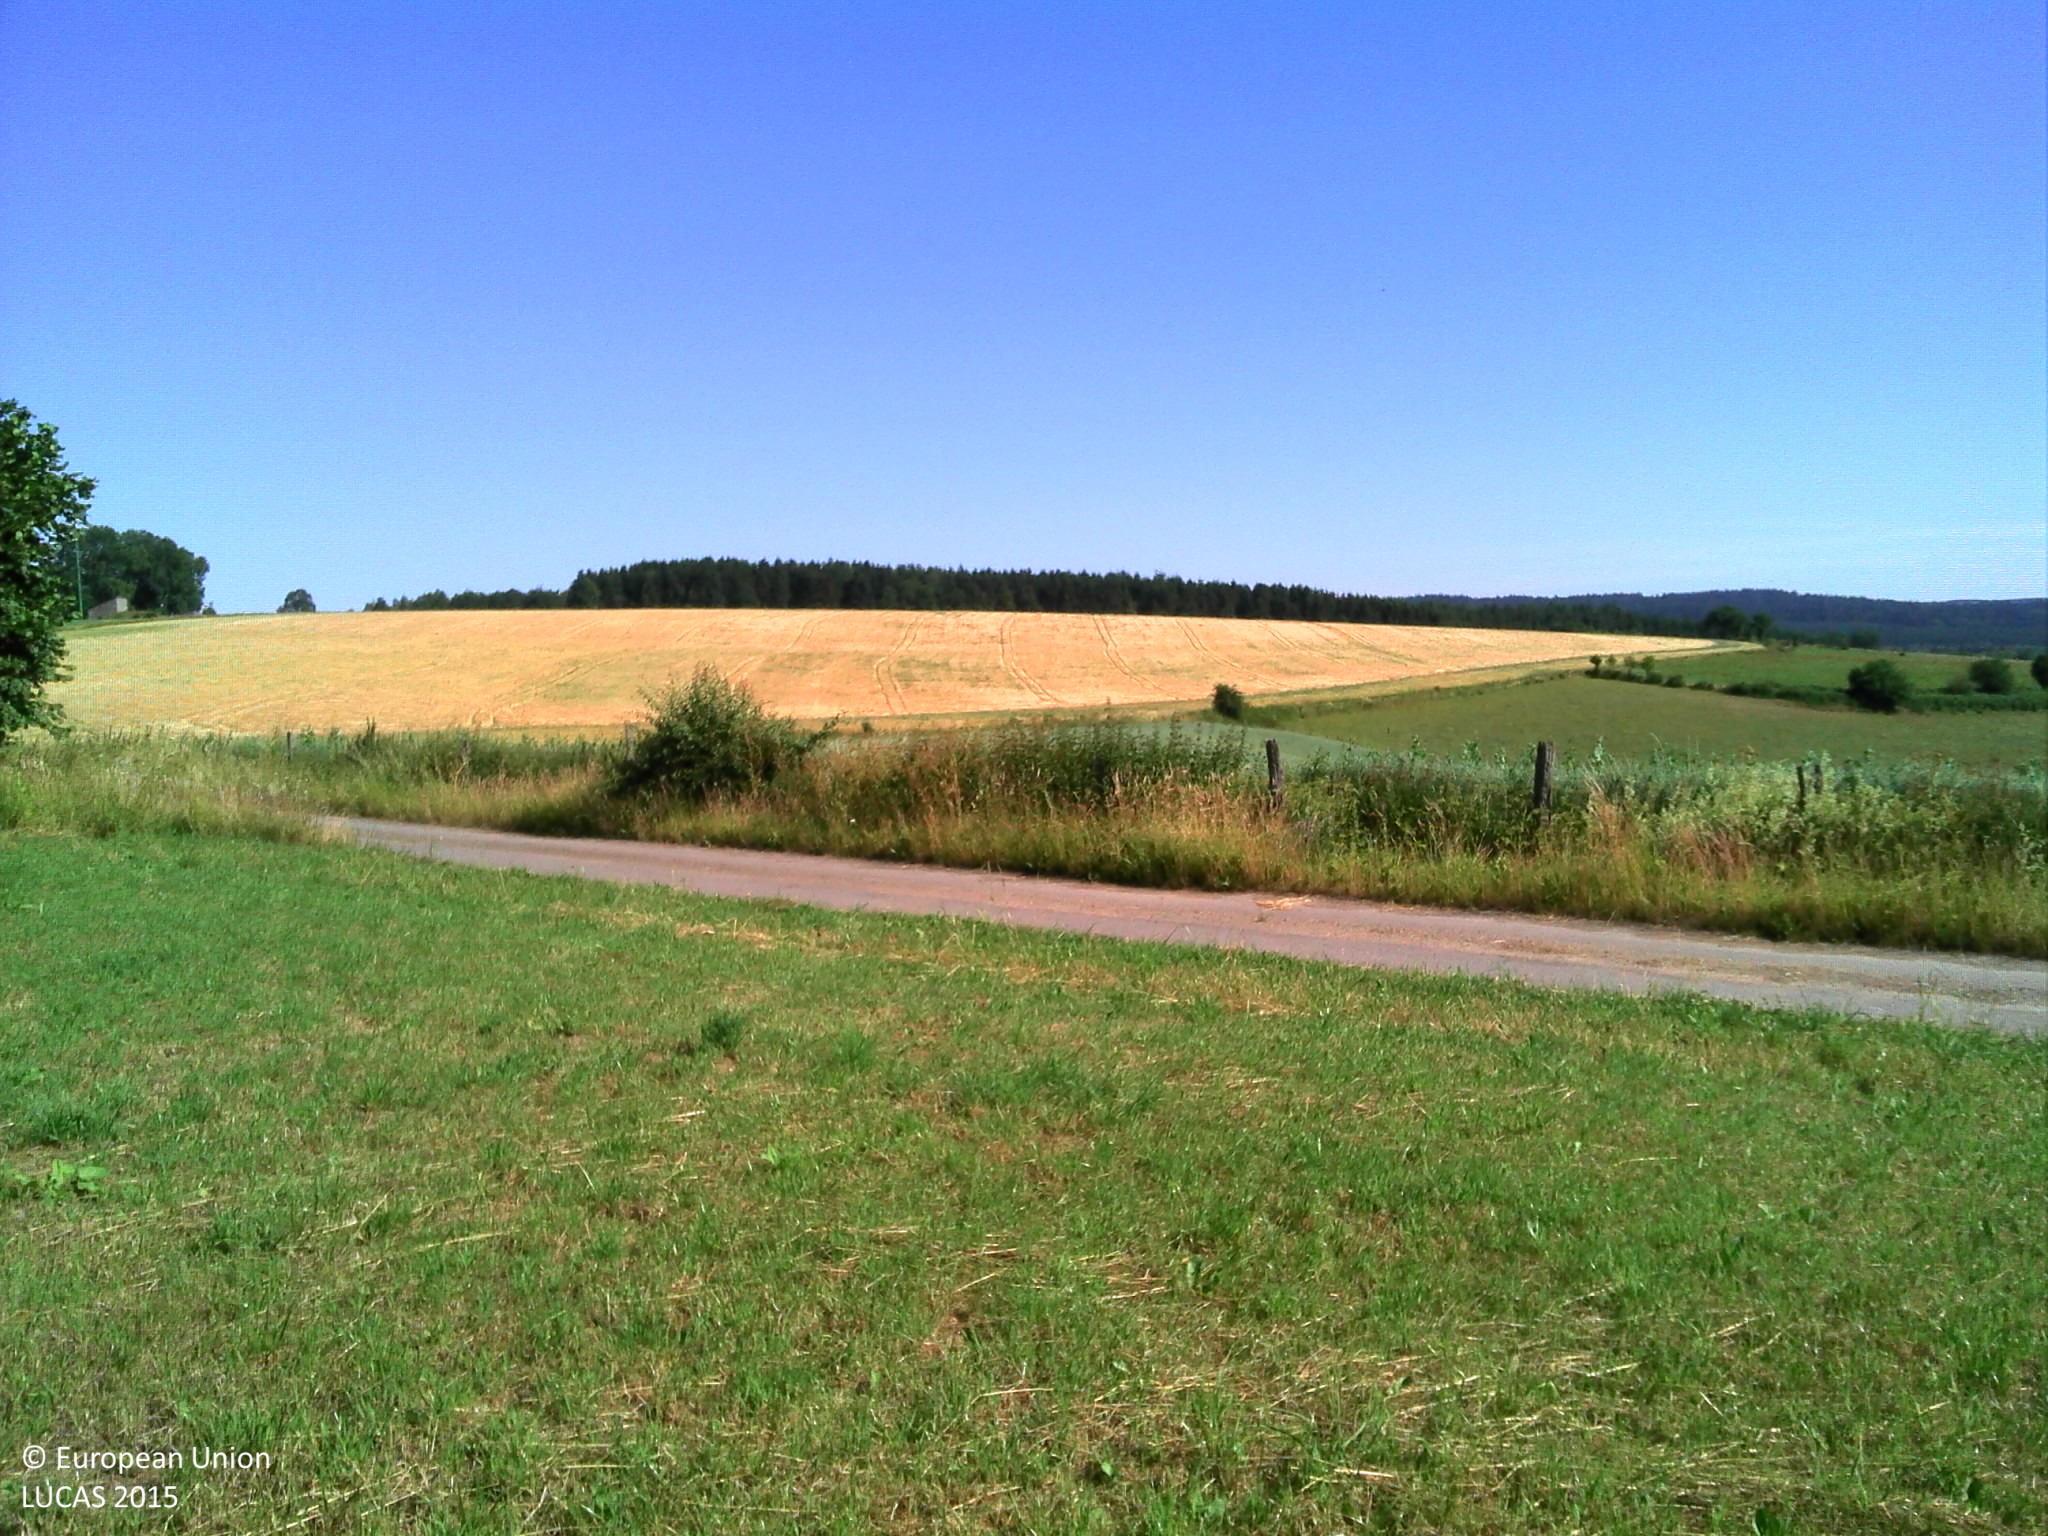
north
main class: Grassland
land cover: Grassland without tree/shrub cover
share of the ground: > 75 %
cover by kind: herbaceous plants 100 %
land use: Agriculture (excluding fallow land and kitchen gardens)
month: July
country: BE
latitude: 50.1604
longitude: 5.7854
